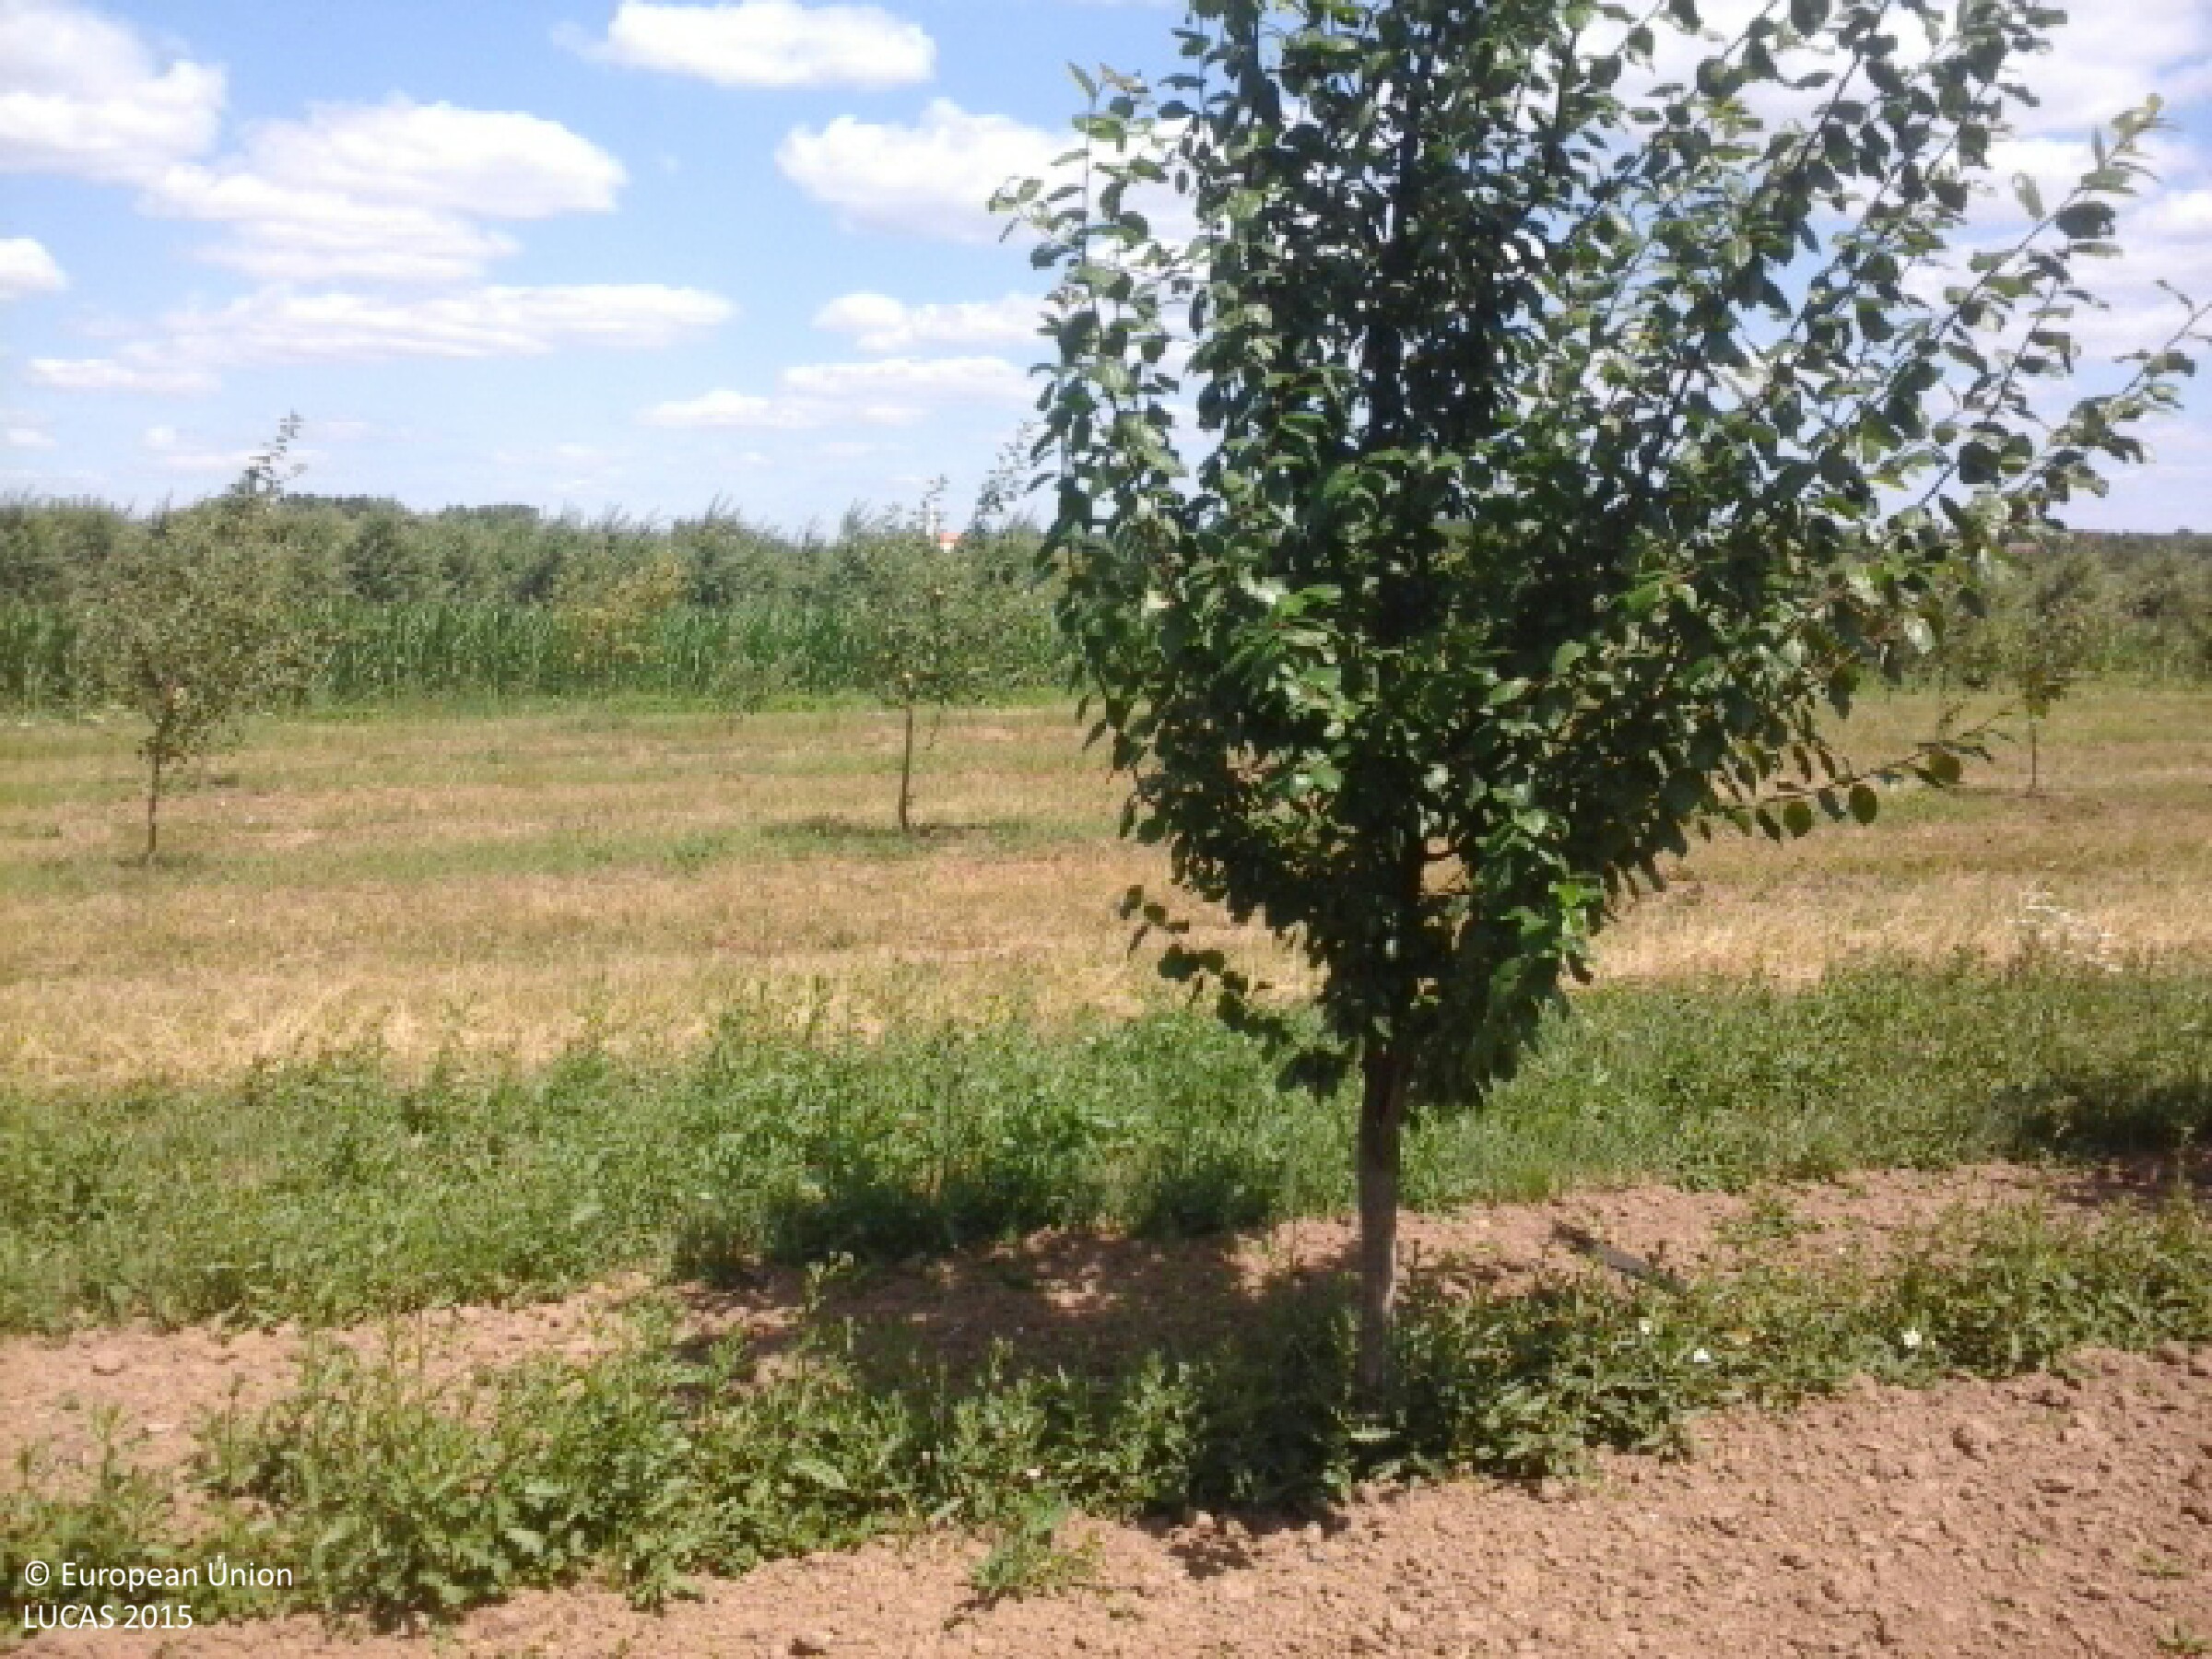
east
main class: Cropland
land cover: Other fruit trees and berries
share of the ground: 10 - 25 %
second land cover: Grassland without tree/shrub cover
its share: > 75 %
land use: Agriculture (excluding fallow land and kitchen gardens)
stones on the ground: < 10 %
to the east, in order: Other fruit trees and berries; Grassland without tree/shrub cover; Apple fruit; Grass margins; Maize; Grass margins; Apple fruit; Grassland without tree/shrub cover; Sunflower; Paved roads, cycling and walking lanes; Apple fruit; Oats; Maize
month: July
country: HU
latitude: 48.2919
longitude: 22.0090
